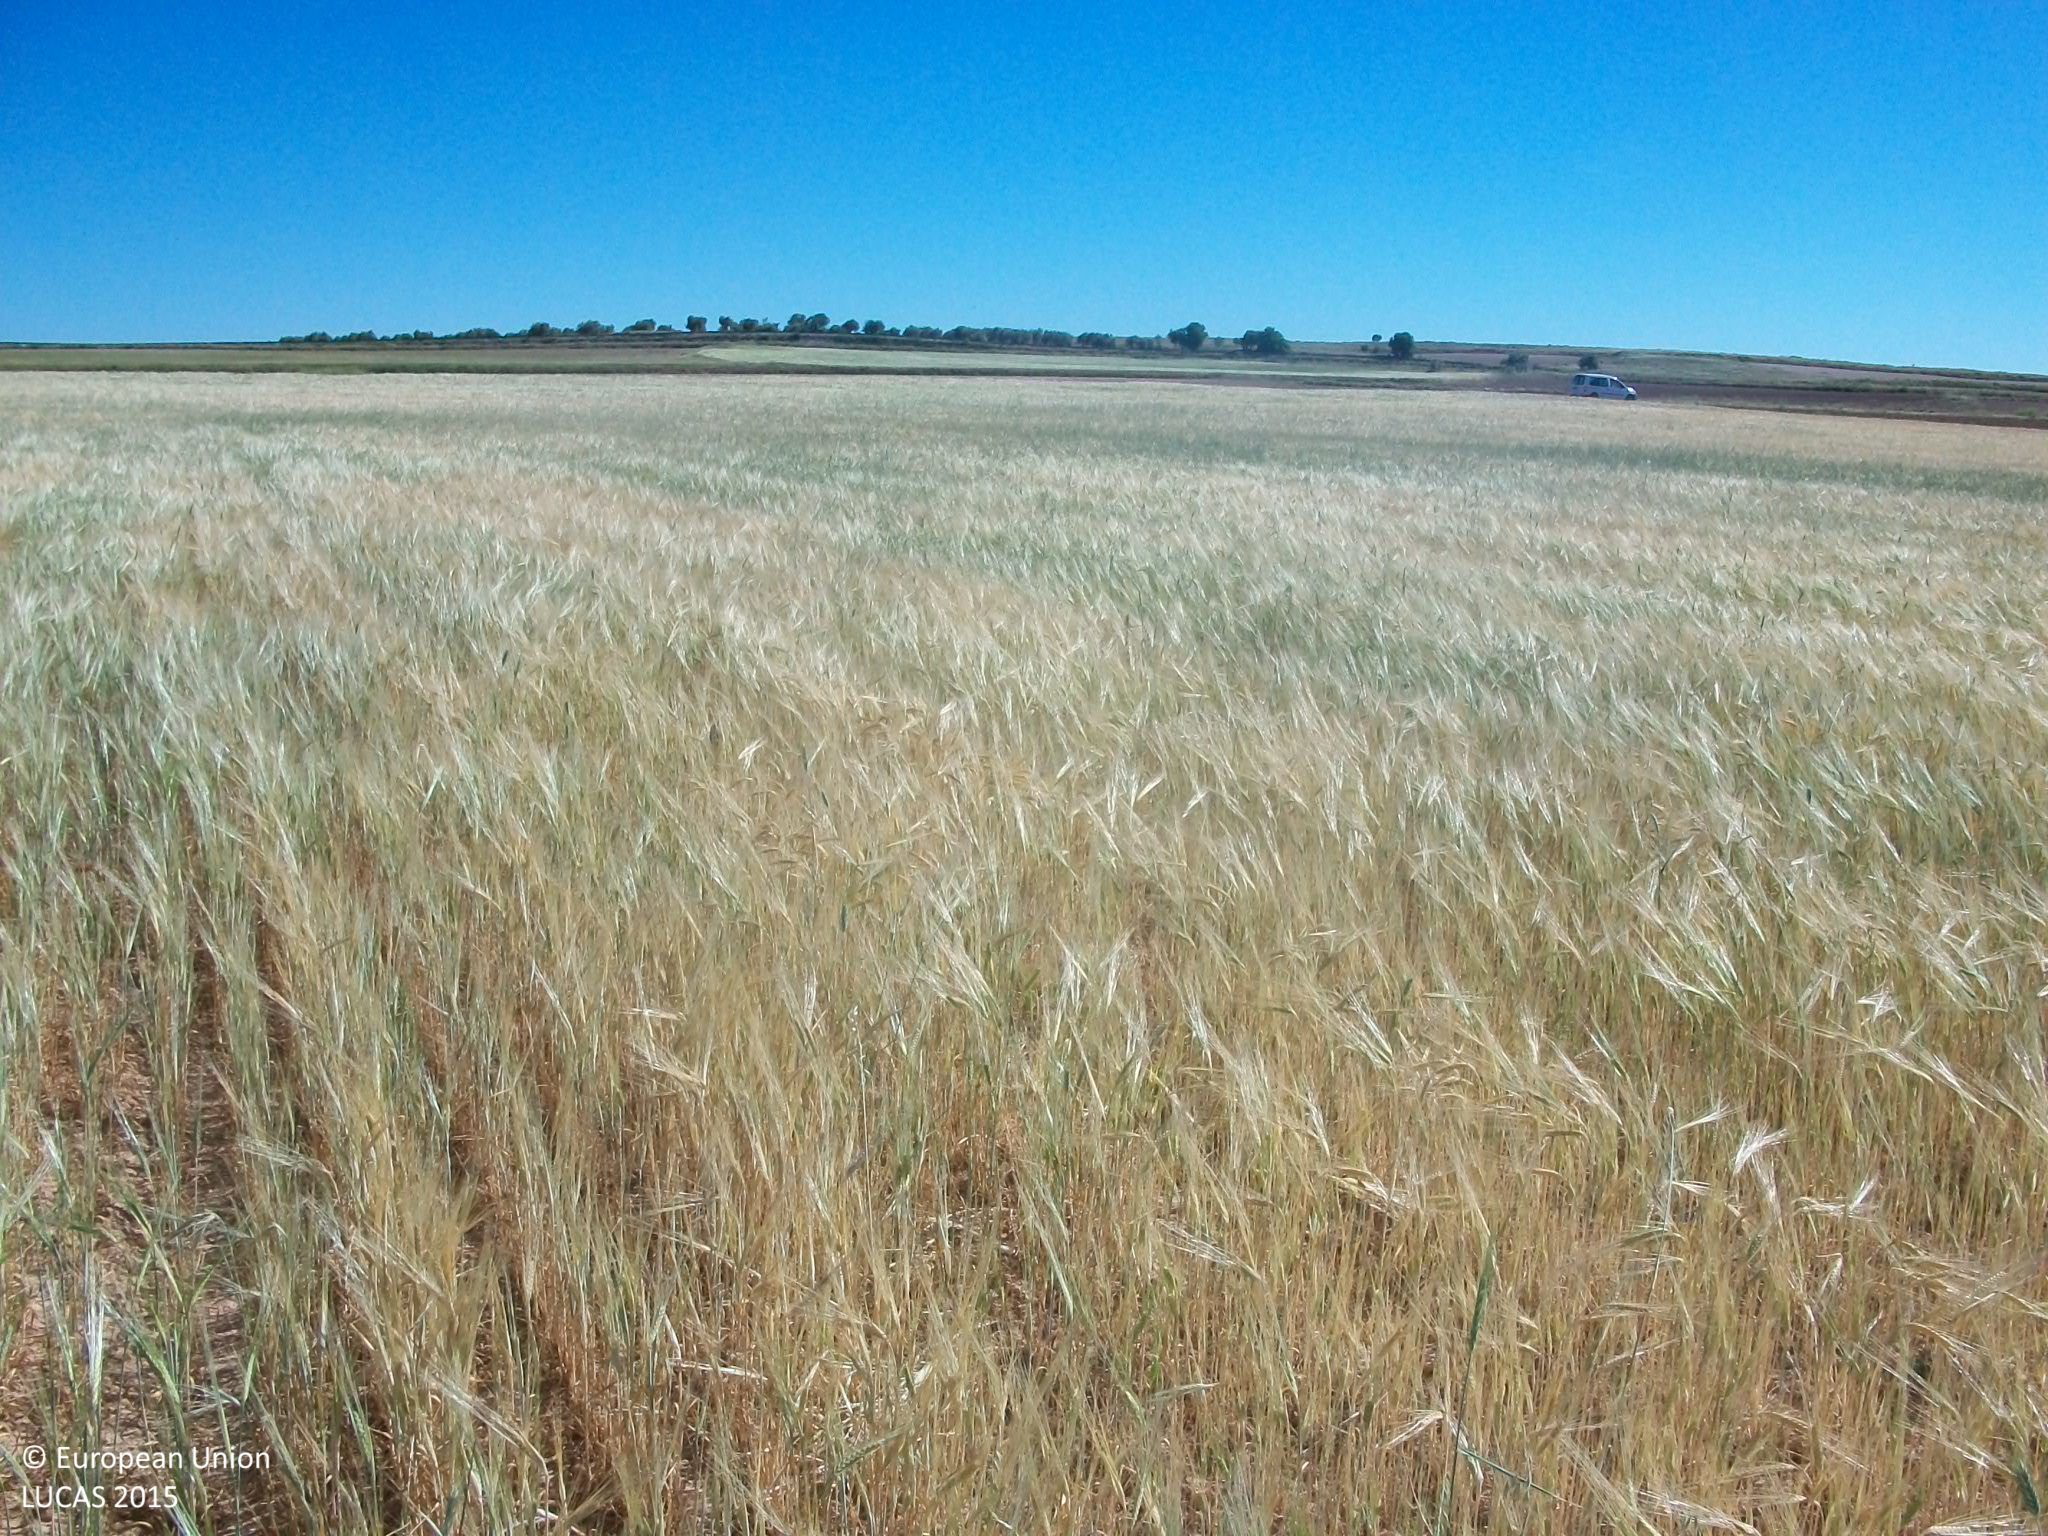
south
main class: Cropland
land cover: Barley
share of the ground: > 75 %
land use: Agriculture (excluding fallow land and kitchen gardens)
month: May
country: ES
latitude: 39.7774
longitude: -3.4409
